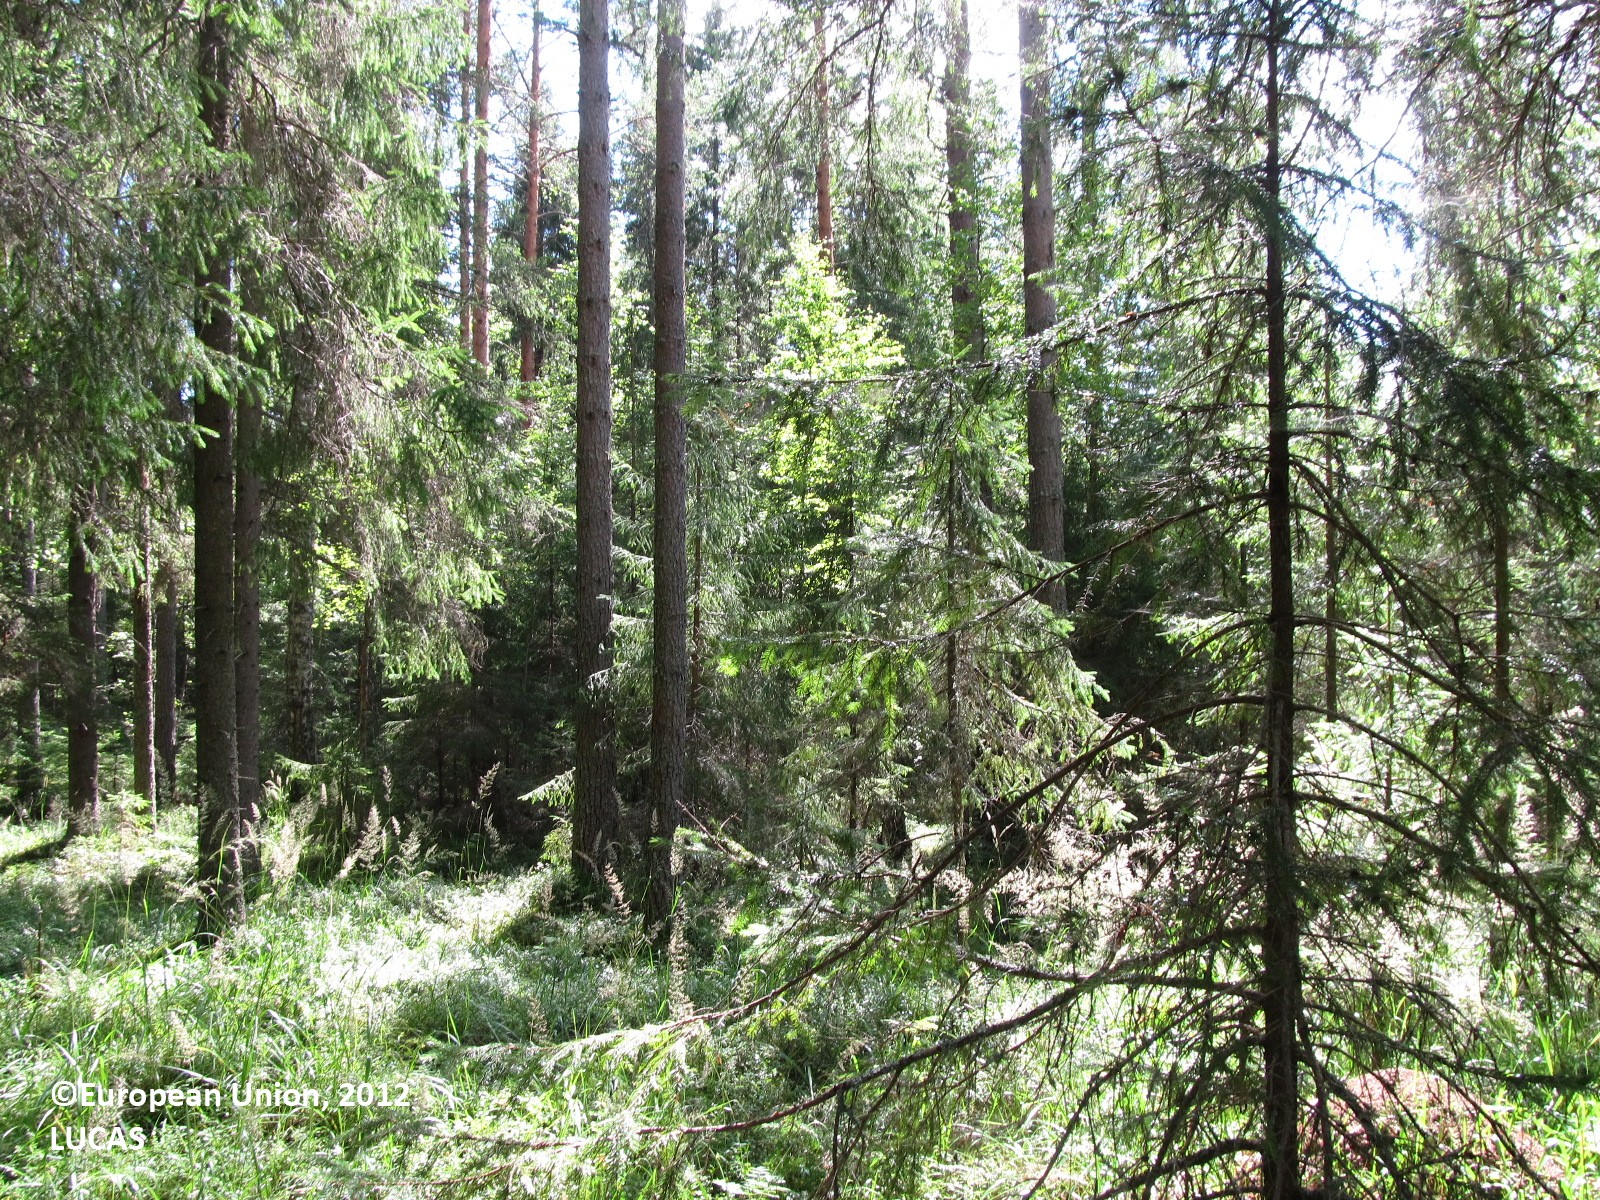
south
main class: Woodland
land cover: Spruce dominated coniferous woodland
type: boreal forest
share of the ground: 50 - 75 %
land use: Forestry
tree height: > 5 m
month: July
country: FI
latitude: 61.9482
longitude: 27.9336
